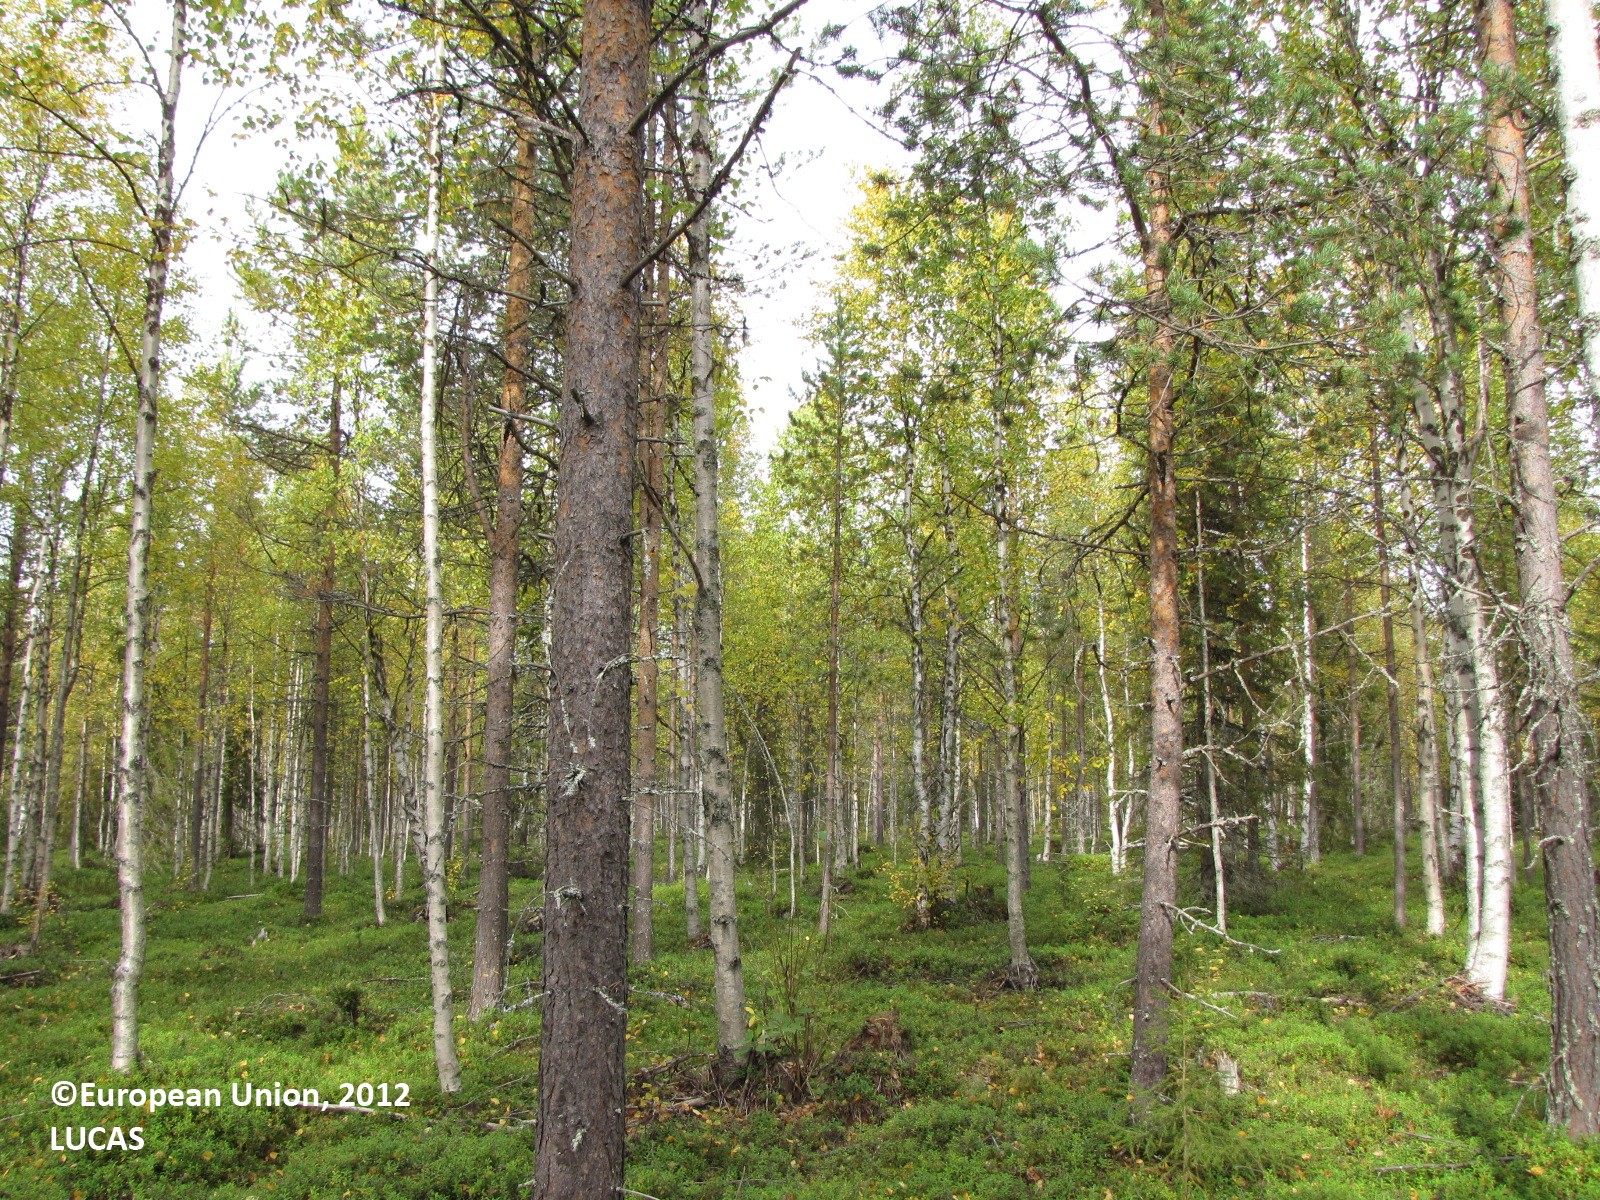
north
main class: Woodland
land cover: Other mixed woodland
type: boreal forest
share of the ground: 50 - 75 %
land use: Forestry
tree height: > 5 m
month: September
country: FI
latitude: 67.2572
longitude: 24.8994
